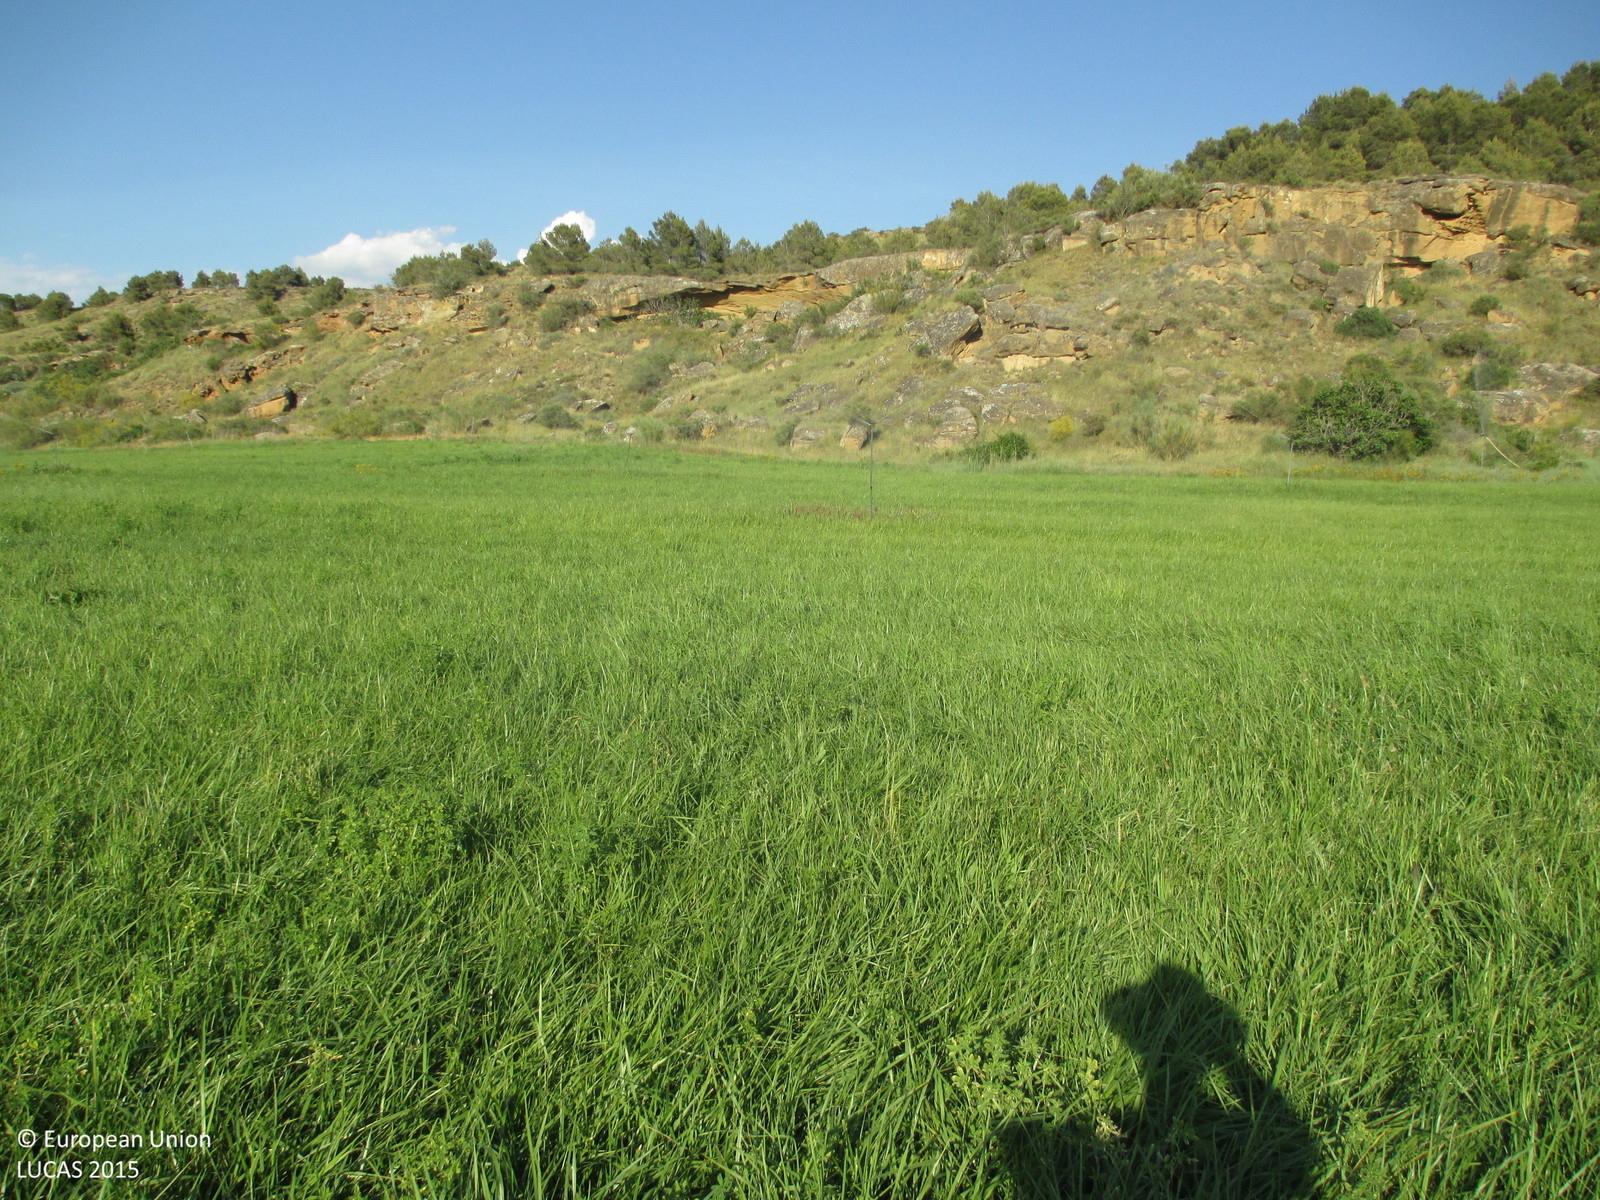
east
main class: Cropland
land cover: Other leguminous and mixtures for fodder
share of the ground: > 75 %
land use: Agriculture (excluding fallow land and kitchen gardens)
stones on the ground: 25 - 50 %
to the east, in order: Other leguminous and mixtures for fodder; Shrubland without tree cover; Rock outcrops; Shrubland without tree cover; Pine dominated mixed woodland
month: May
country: ES
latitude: 41.8341
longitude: -0.1452
